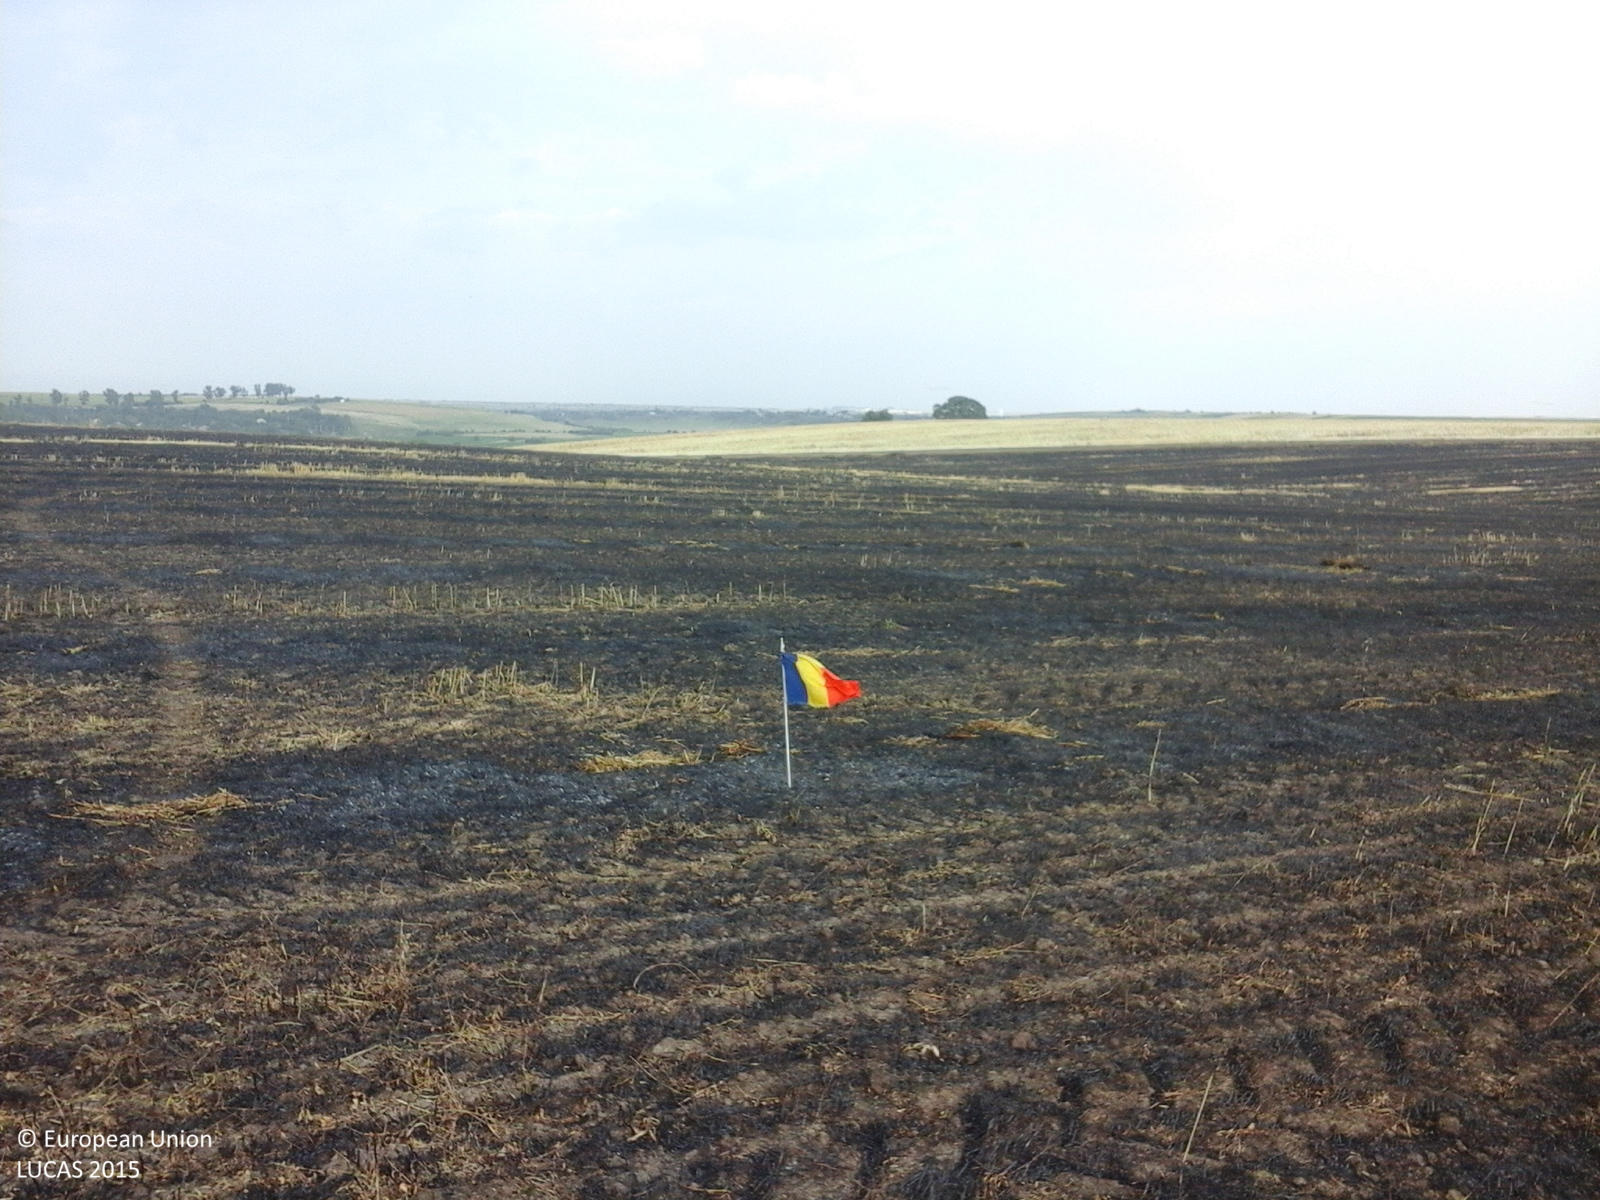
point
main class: Cropland
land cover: Common wheat
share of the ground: < 10 %
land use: Agriculture (excluding fallow land and kitchen gardens)
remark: Burnt area
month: July
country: RO
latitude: 43.9507
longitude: 24.8637
